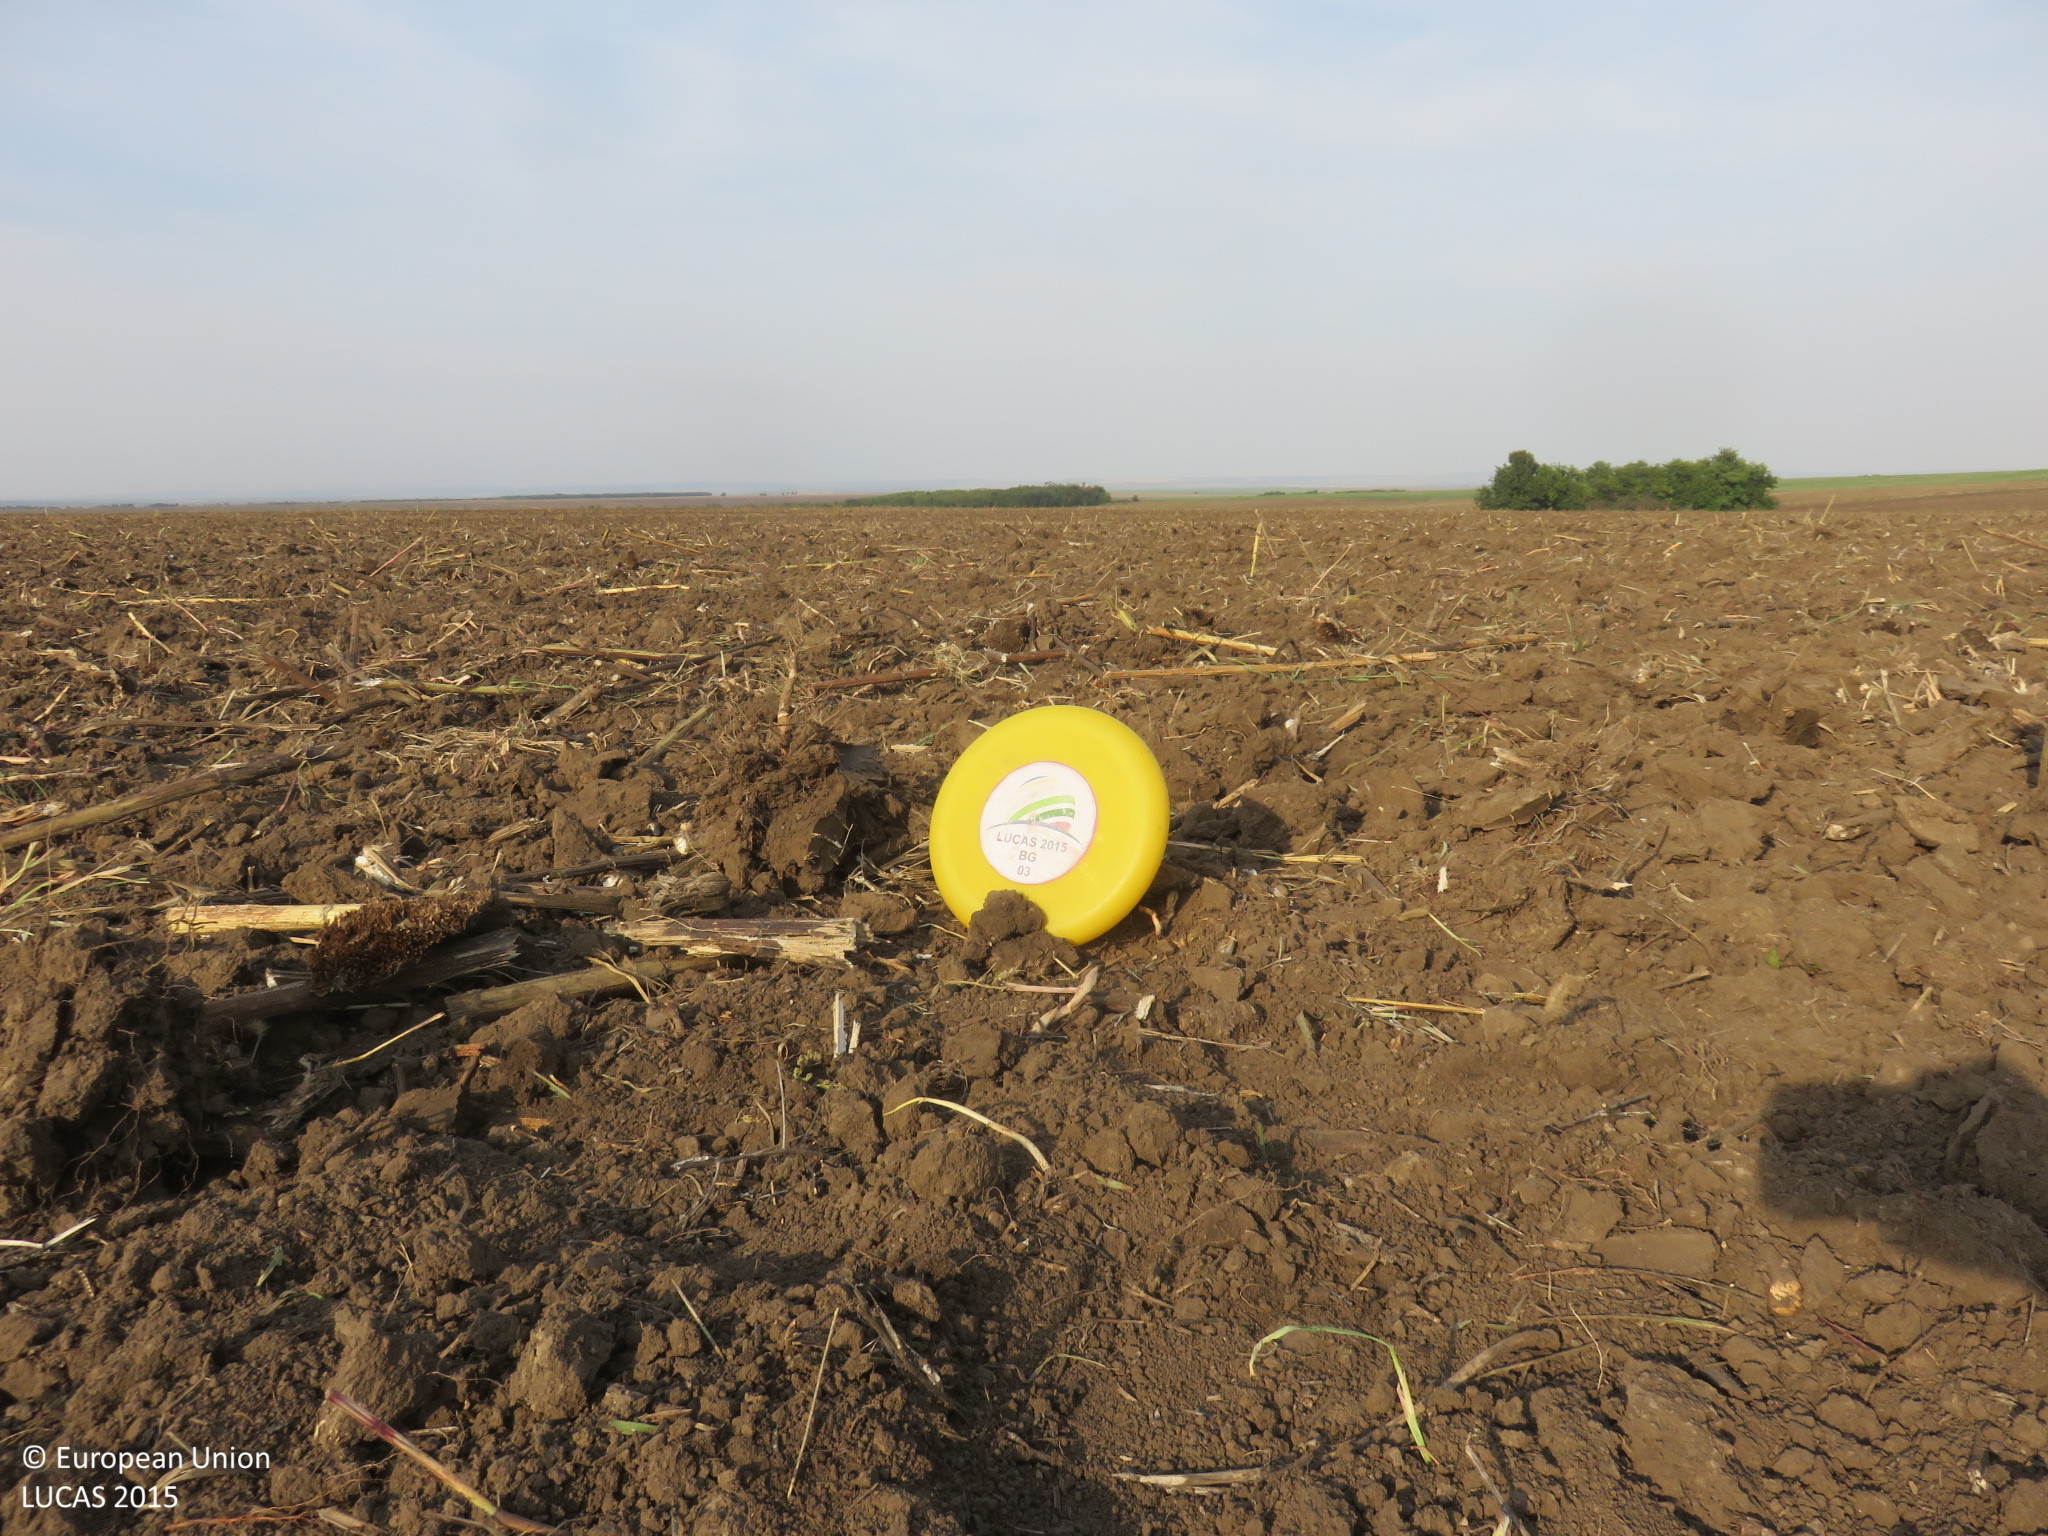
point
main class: Cropland
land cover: Sunflower
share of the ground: < 10 %
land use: Agriculture (excluding fallow land and kitchen gardens)
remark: Harvested field
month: September
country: BG
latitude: 43.3965
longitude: 24.8961
